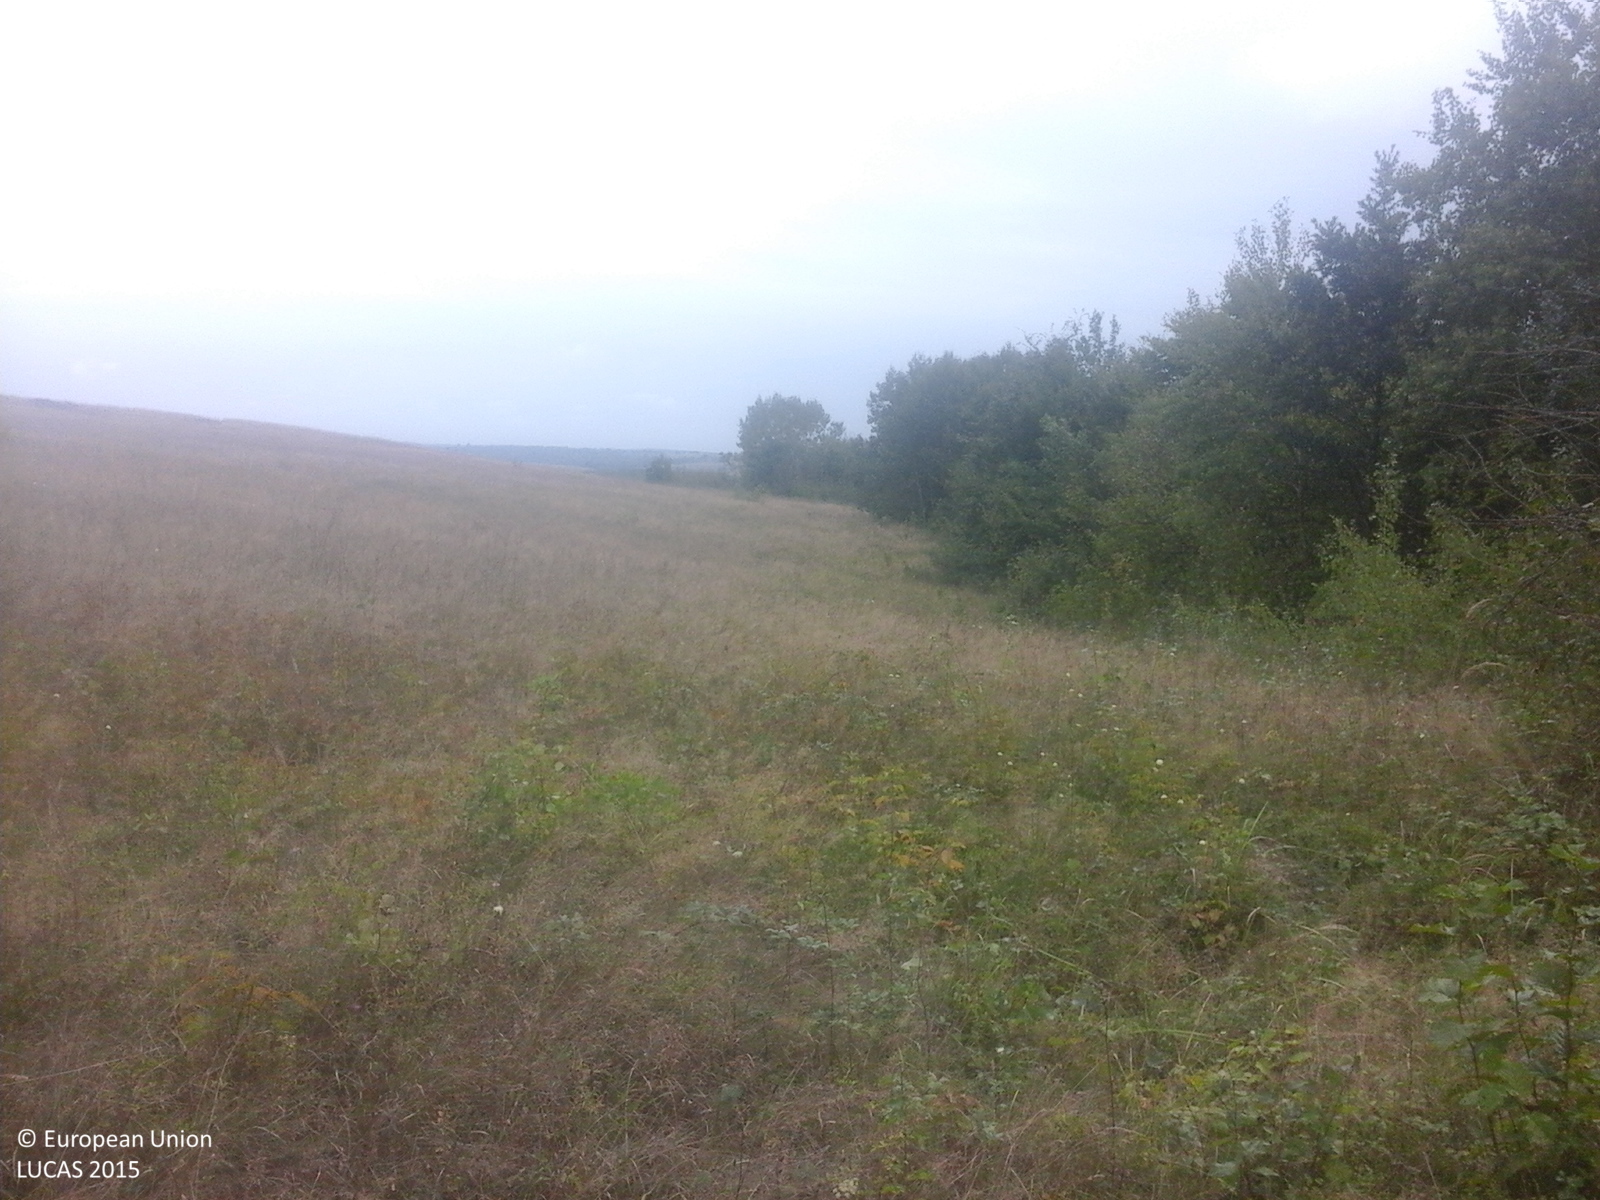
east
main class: Grassland
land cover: Grassland without tree/shrub cover
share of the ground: > 75 %
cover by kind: herbaceous plants 100 %
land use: Agriculture (excluding fallow land and kitchen gardens)
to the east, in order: Grassland without tree/shrub cover; Broadleaved woodland; Grassland without tree/shrub cover; Broadleaved woodland; Grassland without tree/shrub cover
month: September
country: RO
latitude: 45.8663
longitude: 22.0599
